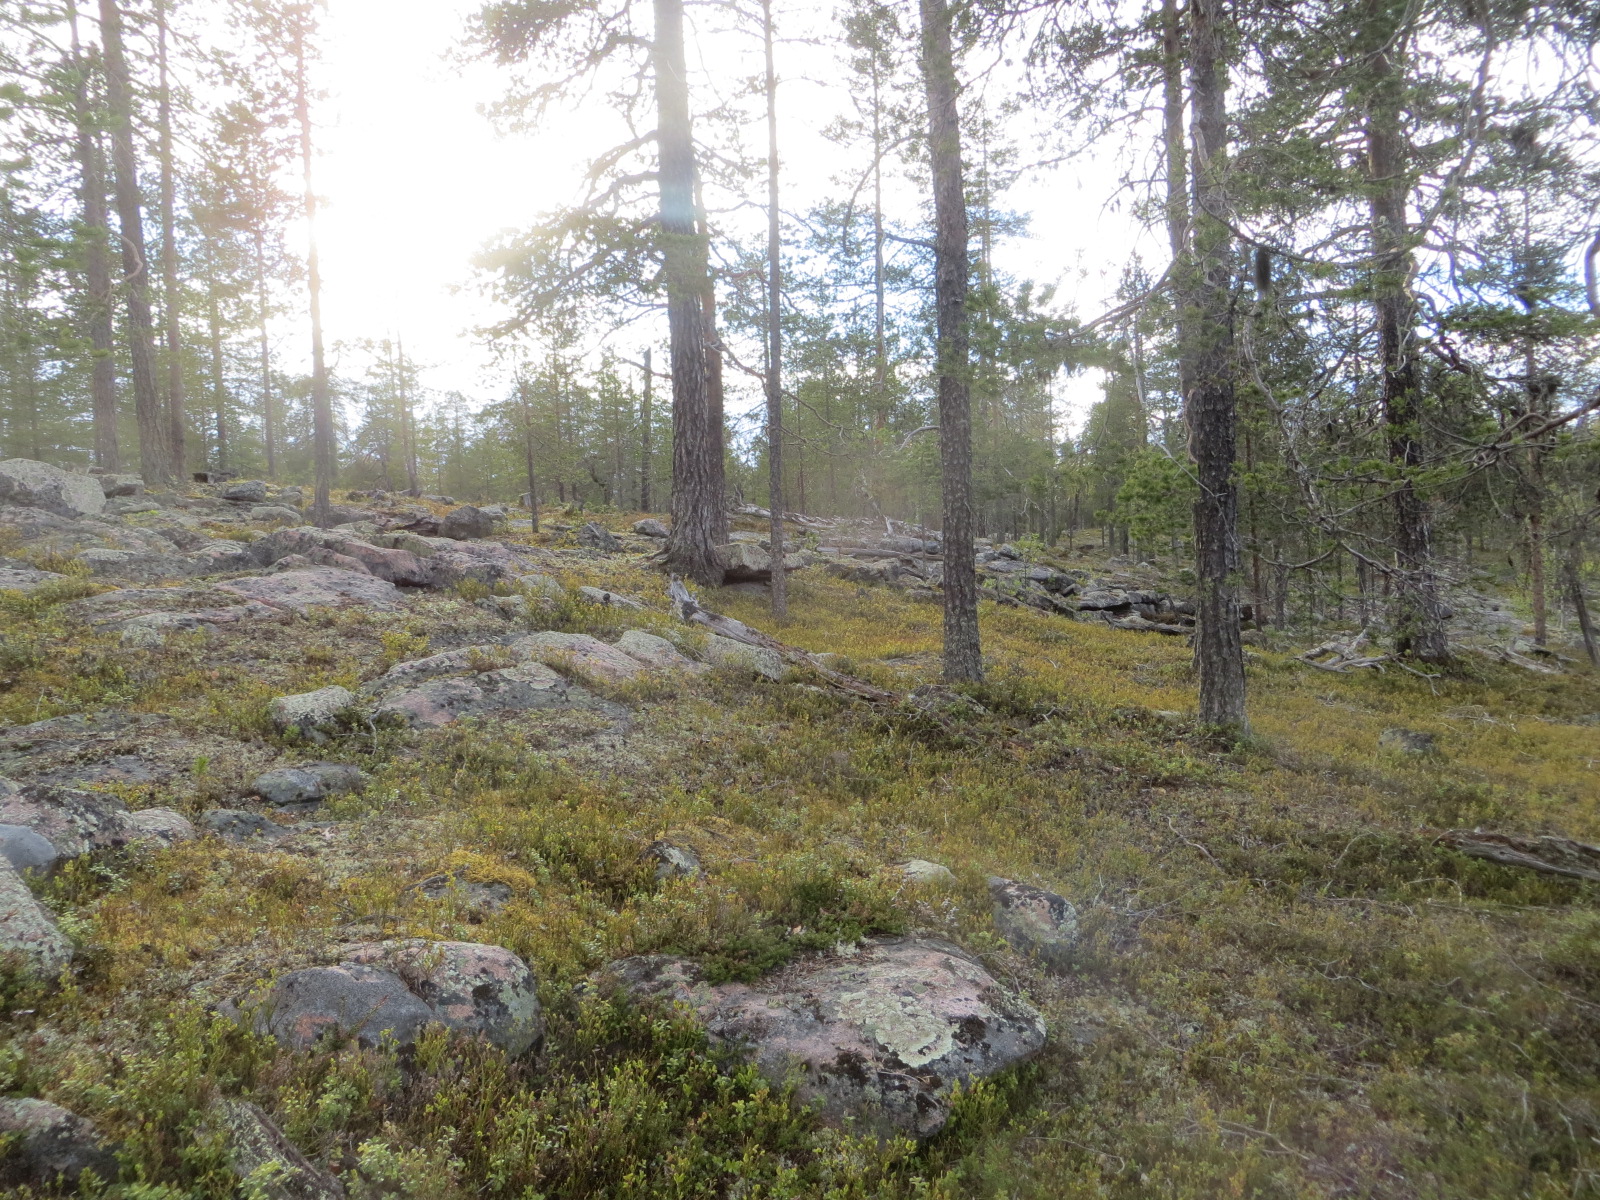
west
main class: Woodland
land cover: Pine dominated coniferous woodland
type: boreal forest
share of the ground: 50 - 75 %
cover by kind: coniferous forest trees 50 %, shrubs 25 %, consolidated bare surface 25 %
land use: Forestry
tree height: > 5 m
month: June
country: FI
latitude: 67.4126
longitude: 25.6620
